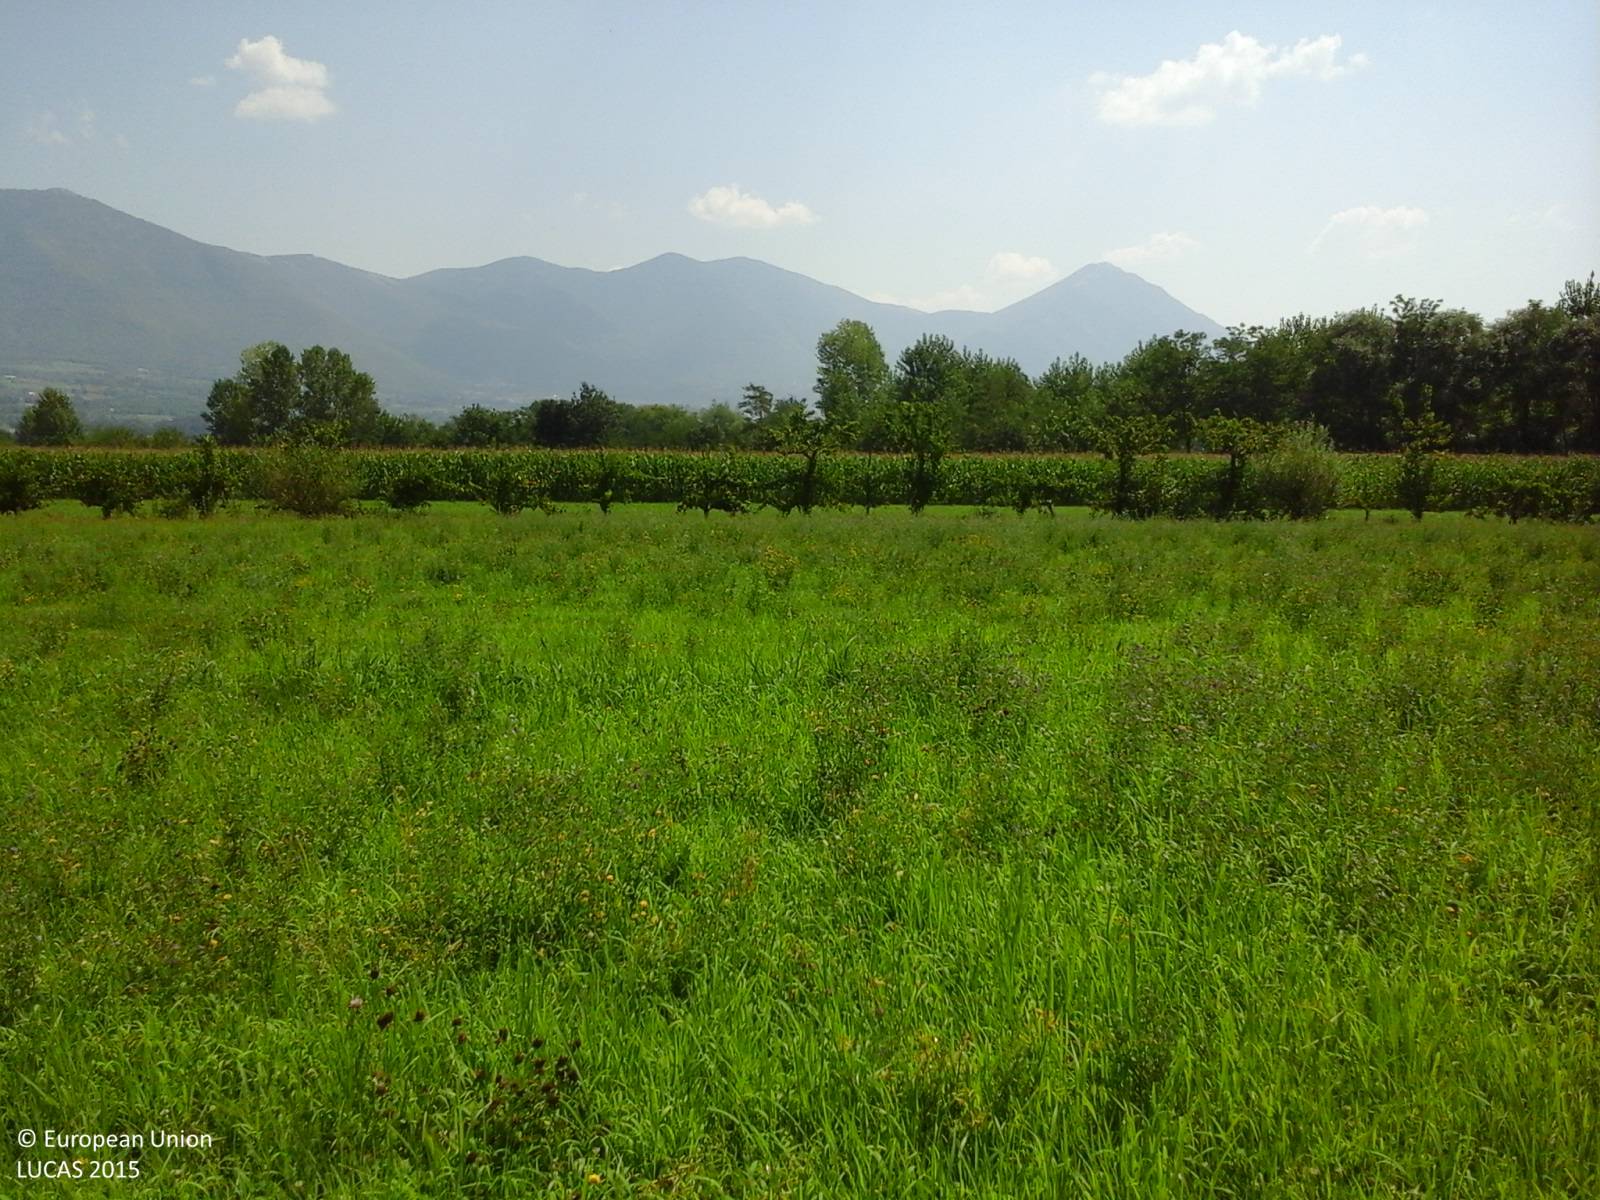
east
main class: Cropland
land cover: Temporary grasslands
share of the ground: > 75 %
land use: Agriculture (excluding fallow land and kitchen gardens)
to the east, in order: Temporary grasslands; Ditches and canals; Lines of trees; Lucerne; Maize; Abandoned hedges; Ditches and canals; Abandoned hedges; Broadleaved woodland; Abandoned hedges
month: August
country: IT
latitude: 41.3113
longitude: 14.3673
